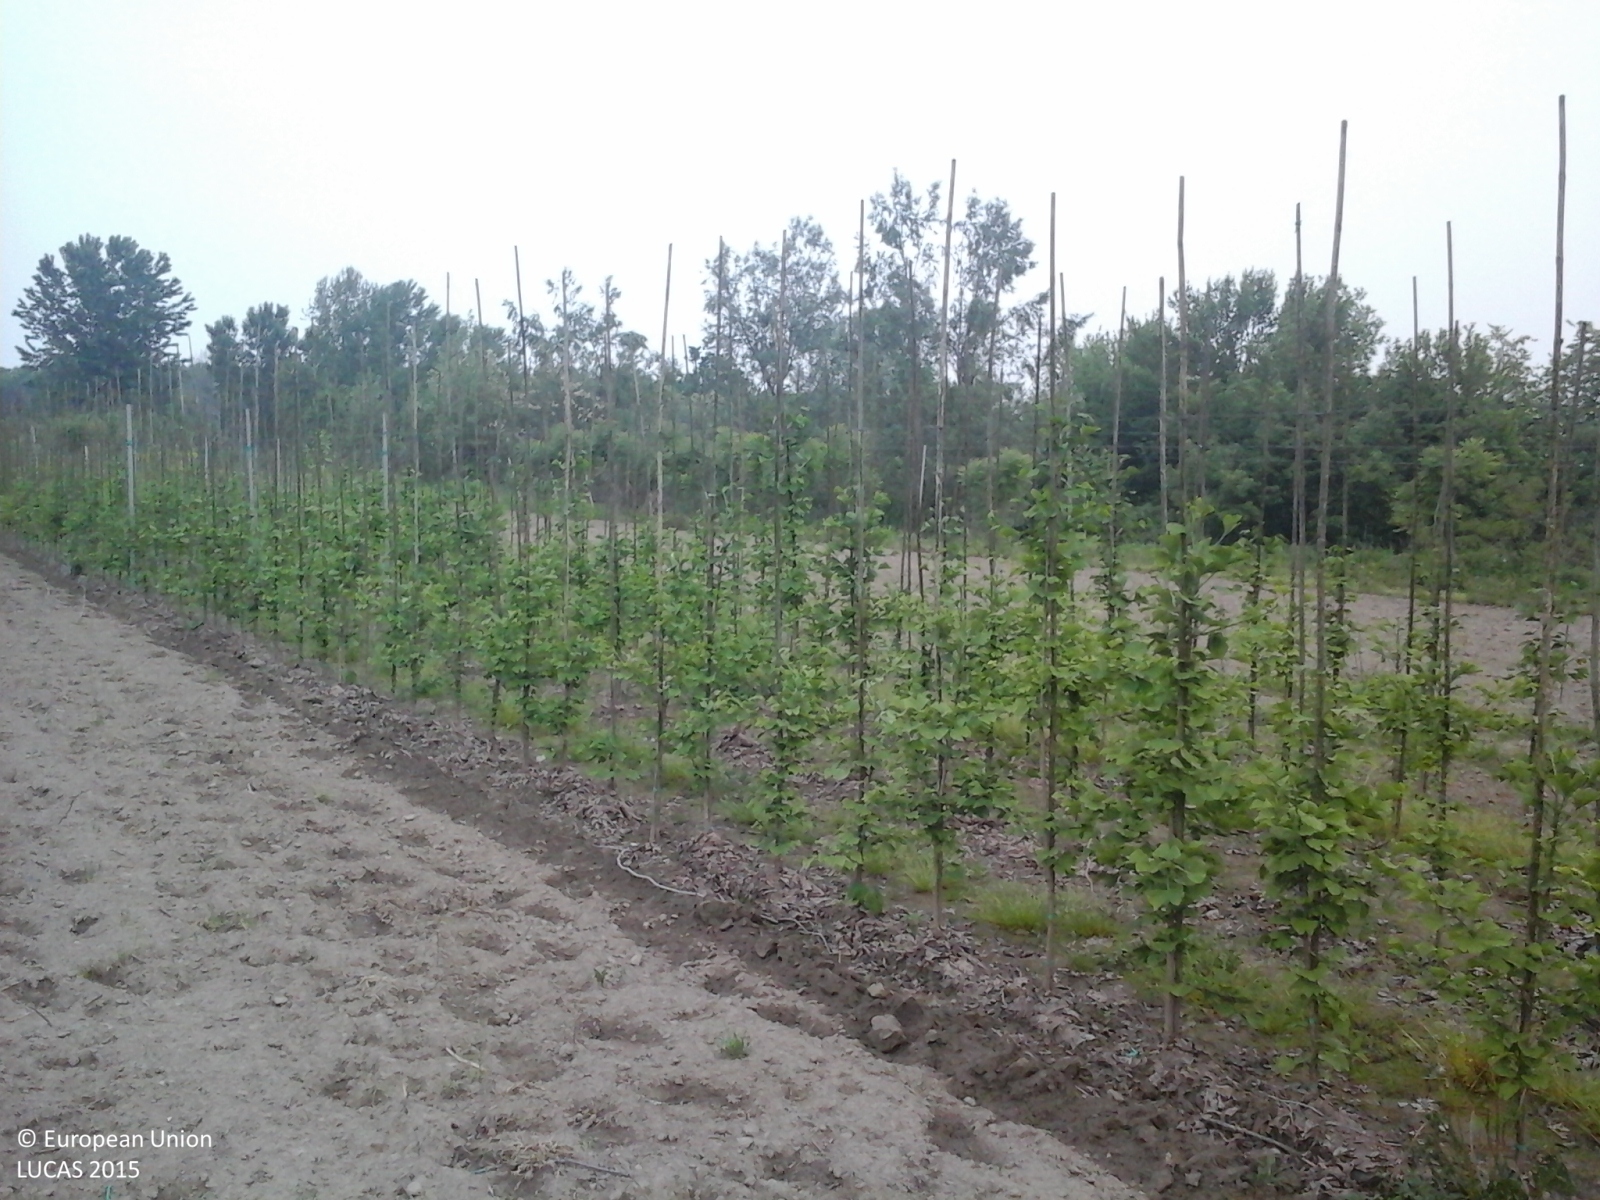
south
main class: Cropland
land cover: Nurseries
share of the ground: < 10 %
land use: Agriculture (excluding fallow land and kitchen gardens)
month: May
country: IT
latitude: 45.1431
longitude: 10.4189
